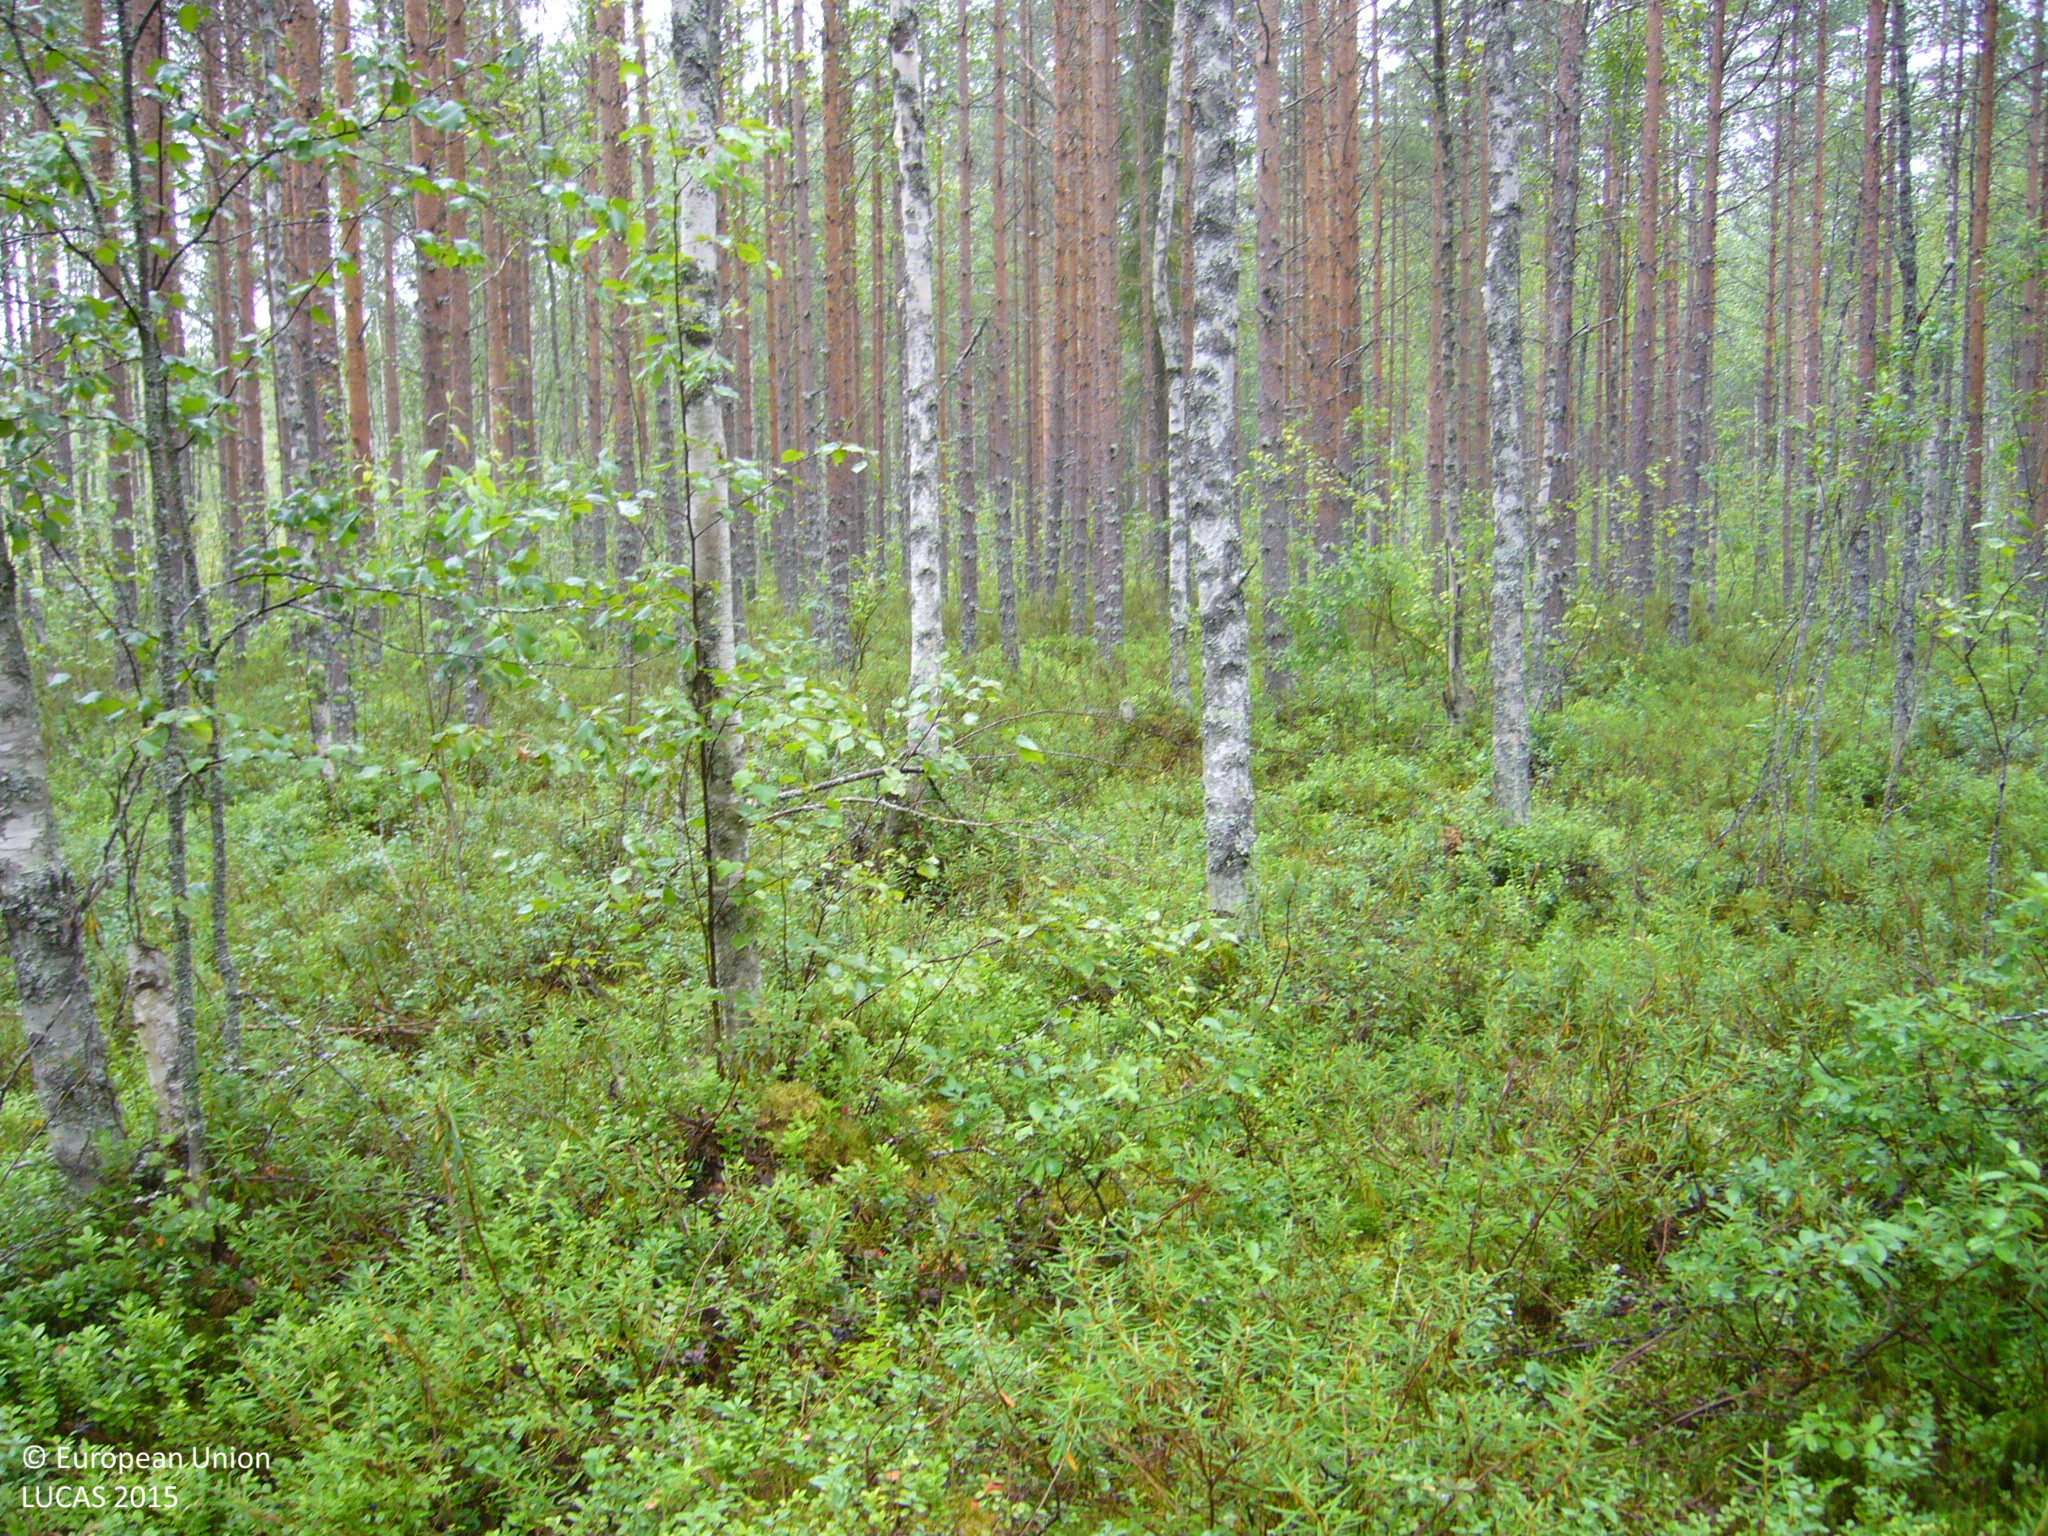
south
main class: Woodland
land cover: Pine dominated mixed woodland
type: boreal forest
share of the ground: 50 - 75 %
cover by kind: coniferous forest trees 40 %, broadleaved forest trees 30 %, shrubs 30 %
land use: Forestry
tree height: > 5 m
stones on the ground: 25 - 50 %
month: July
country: FI
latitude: 64.1668
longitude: 26.2164
